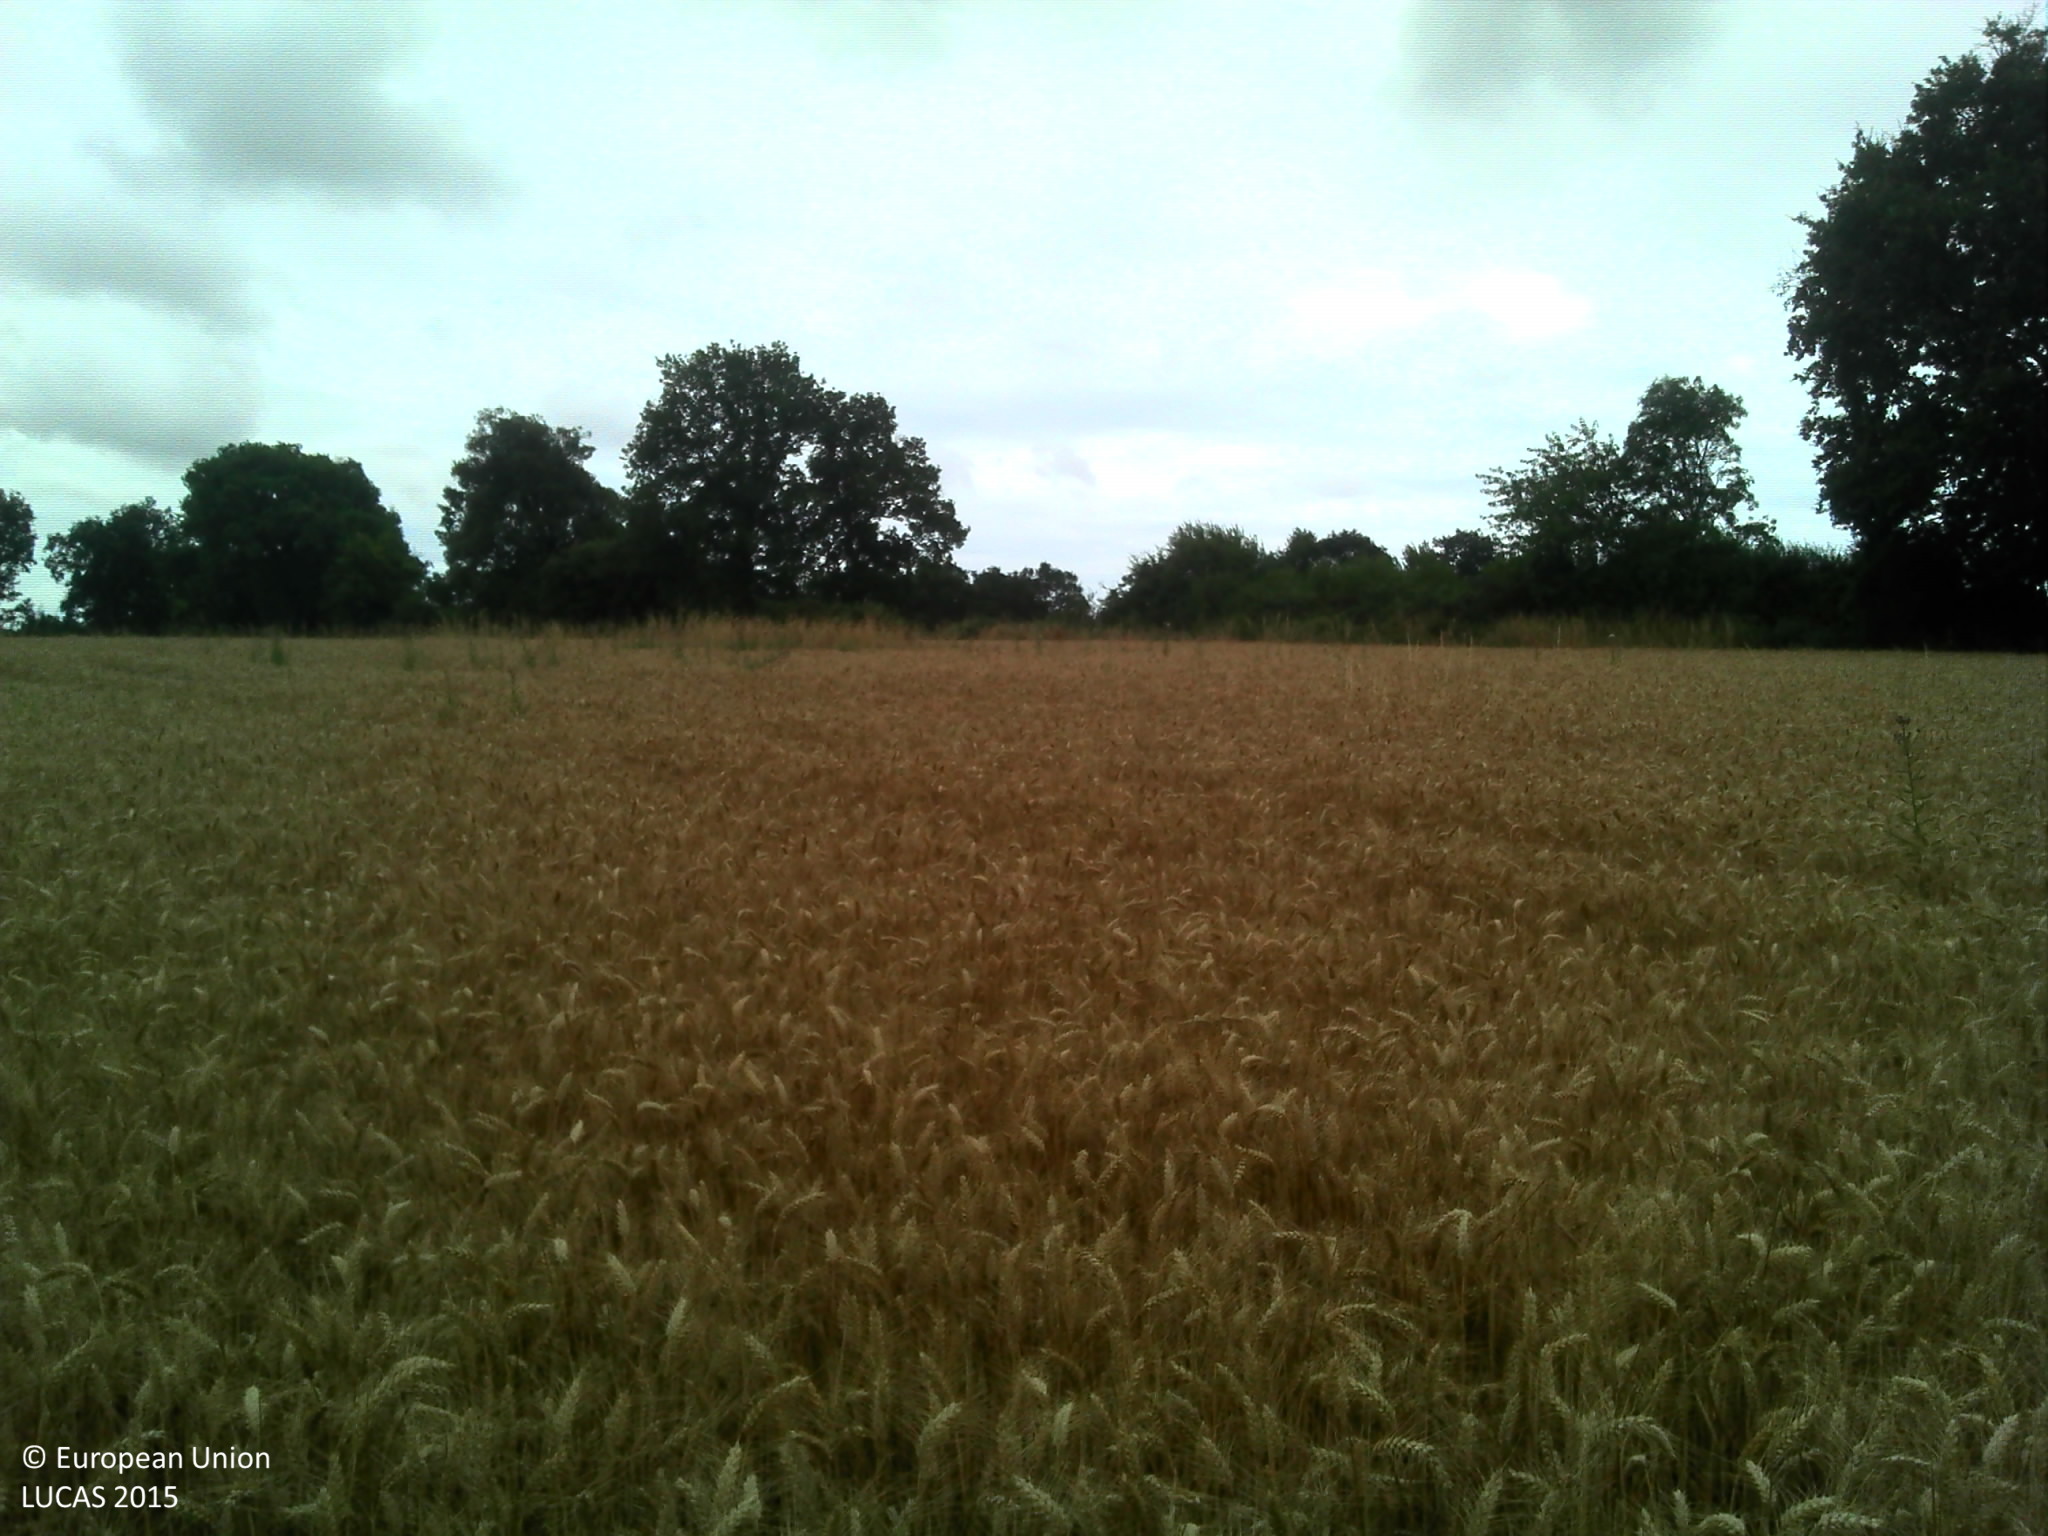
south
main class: Cropland
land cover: Common wheat
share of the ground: > 75 %
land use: Agriculture (excluding fallow land and kitchen gardens)
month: July
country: FR
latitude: 46.4824
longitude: -1.5930
